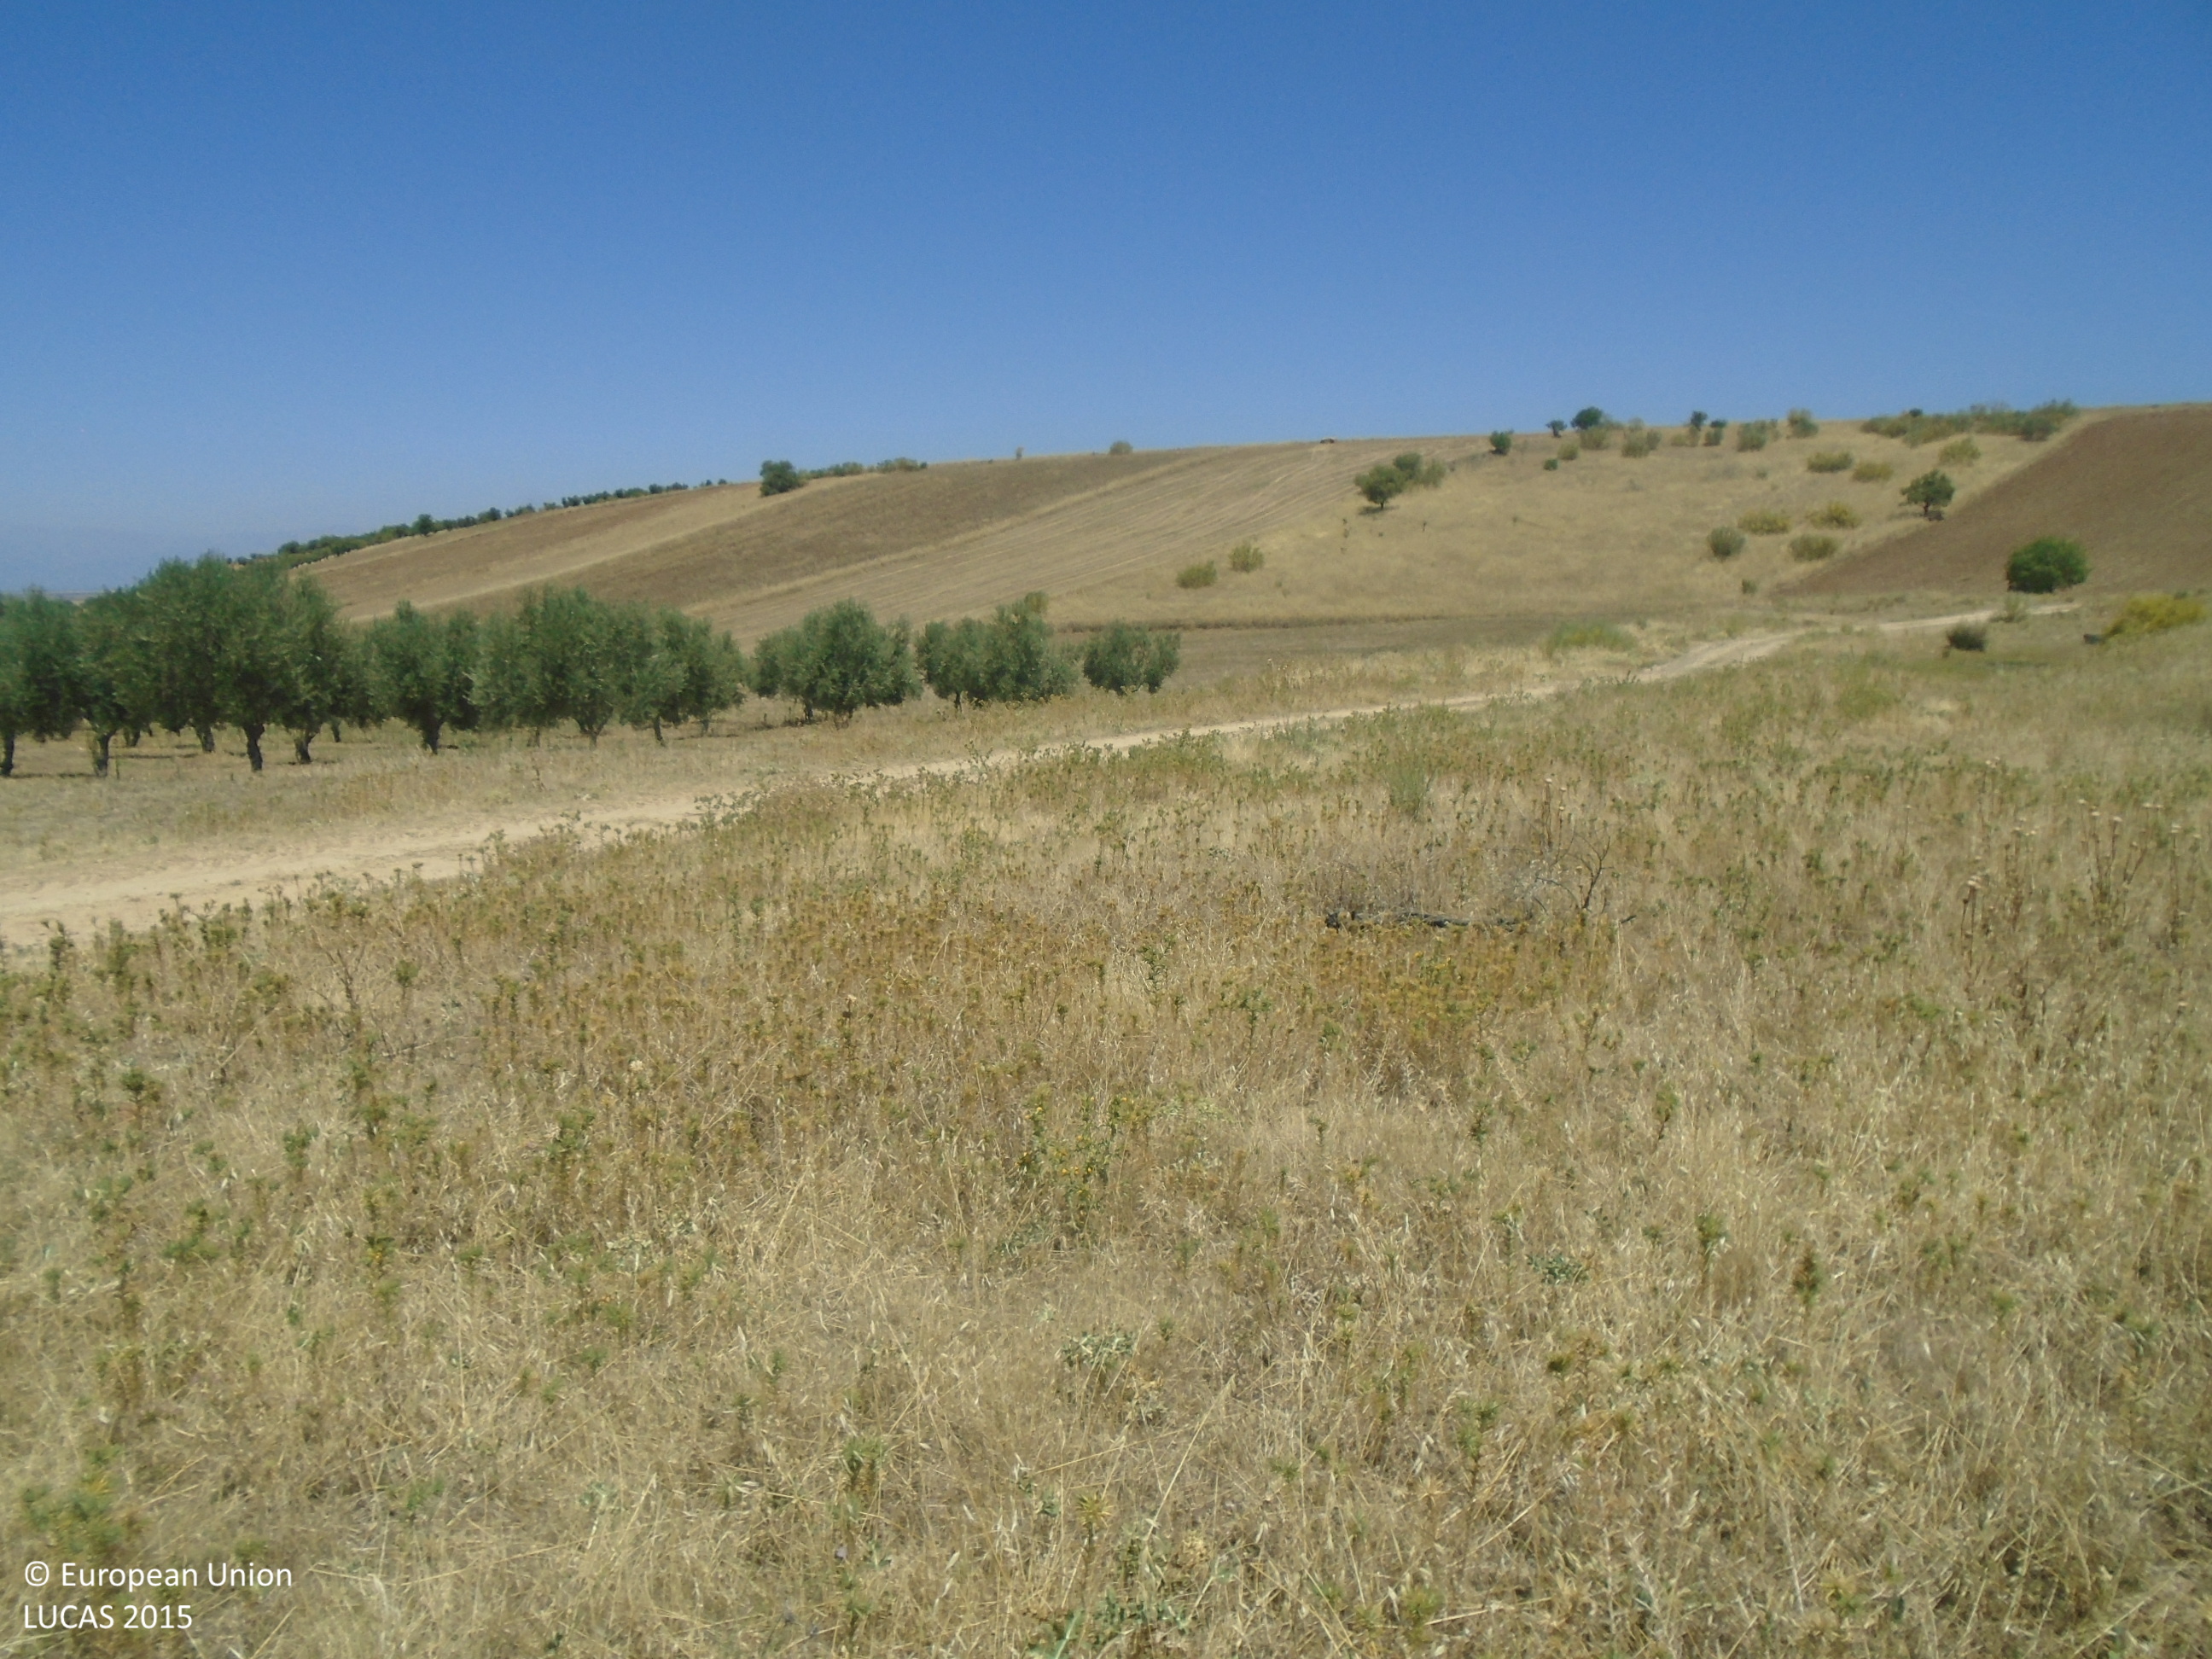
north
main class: Cropland
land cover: Common wheat
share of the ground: > 75 %
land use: Agriculture (excluding fallow land and kitchen gardens)
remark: Harvested field
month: July
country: ES
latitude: 39.7784
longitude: -4.9331
